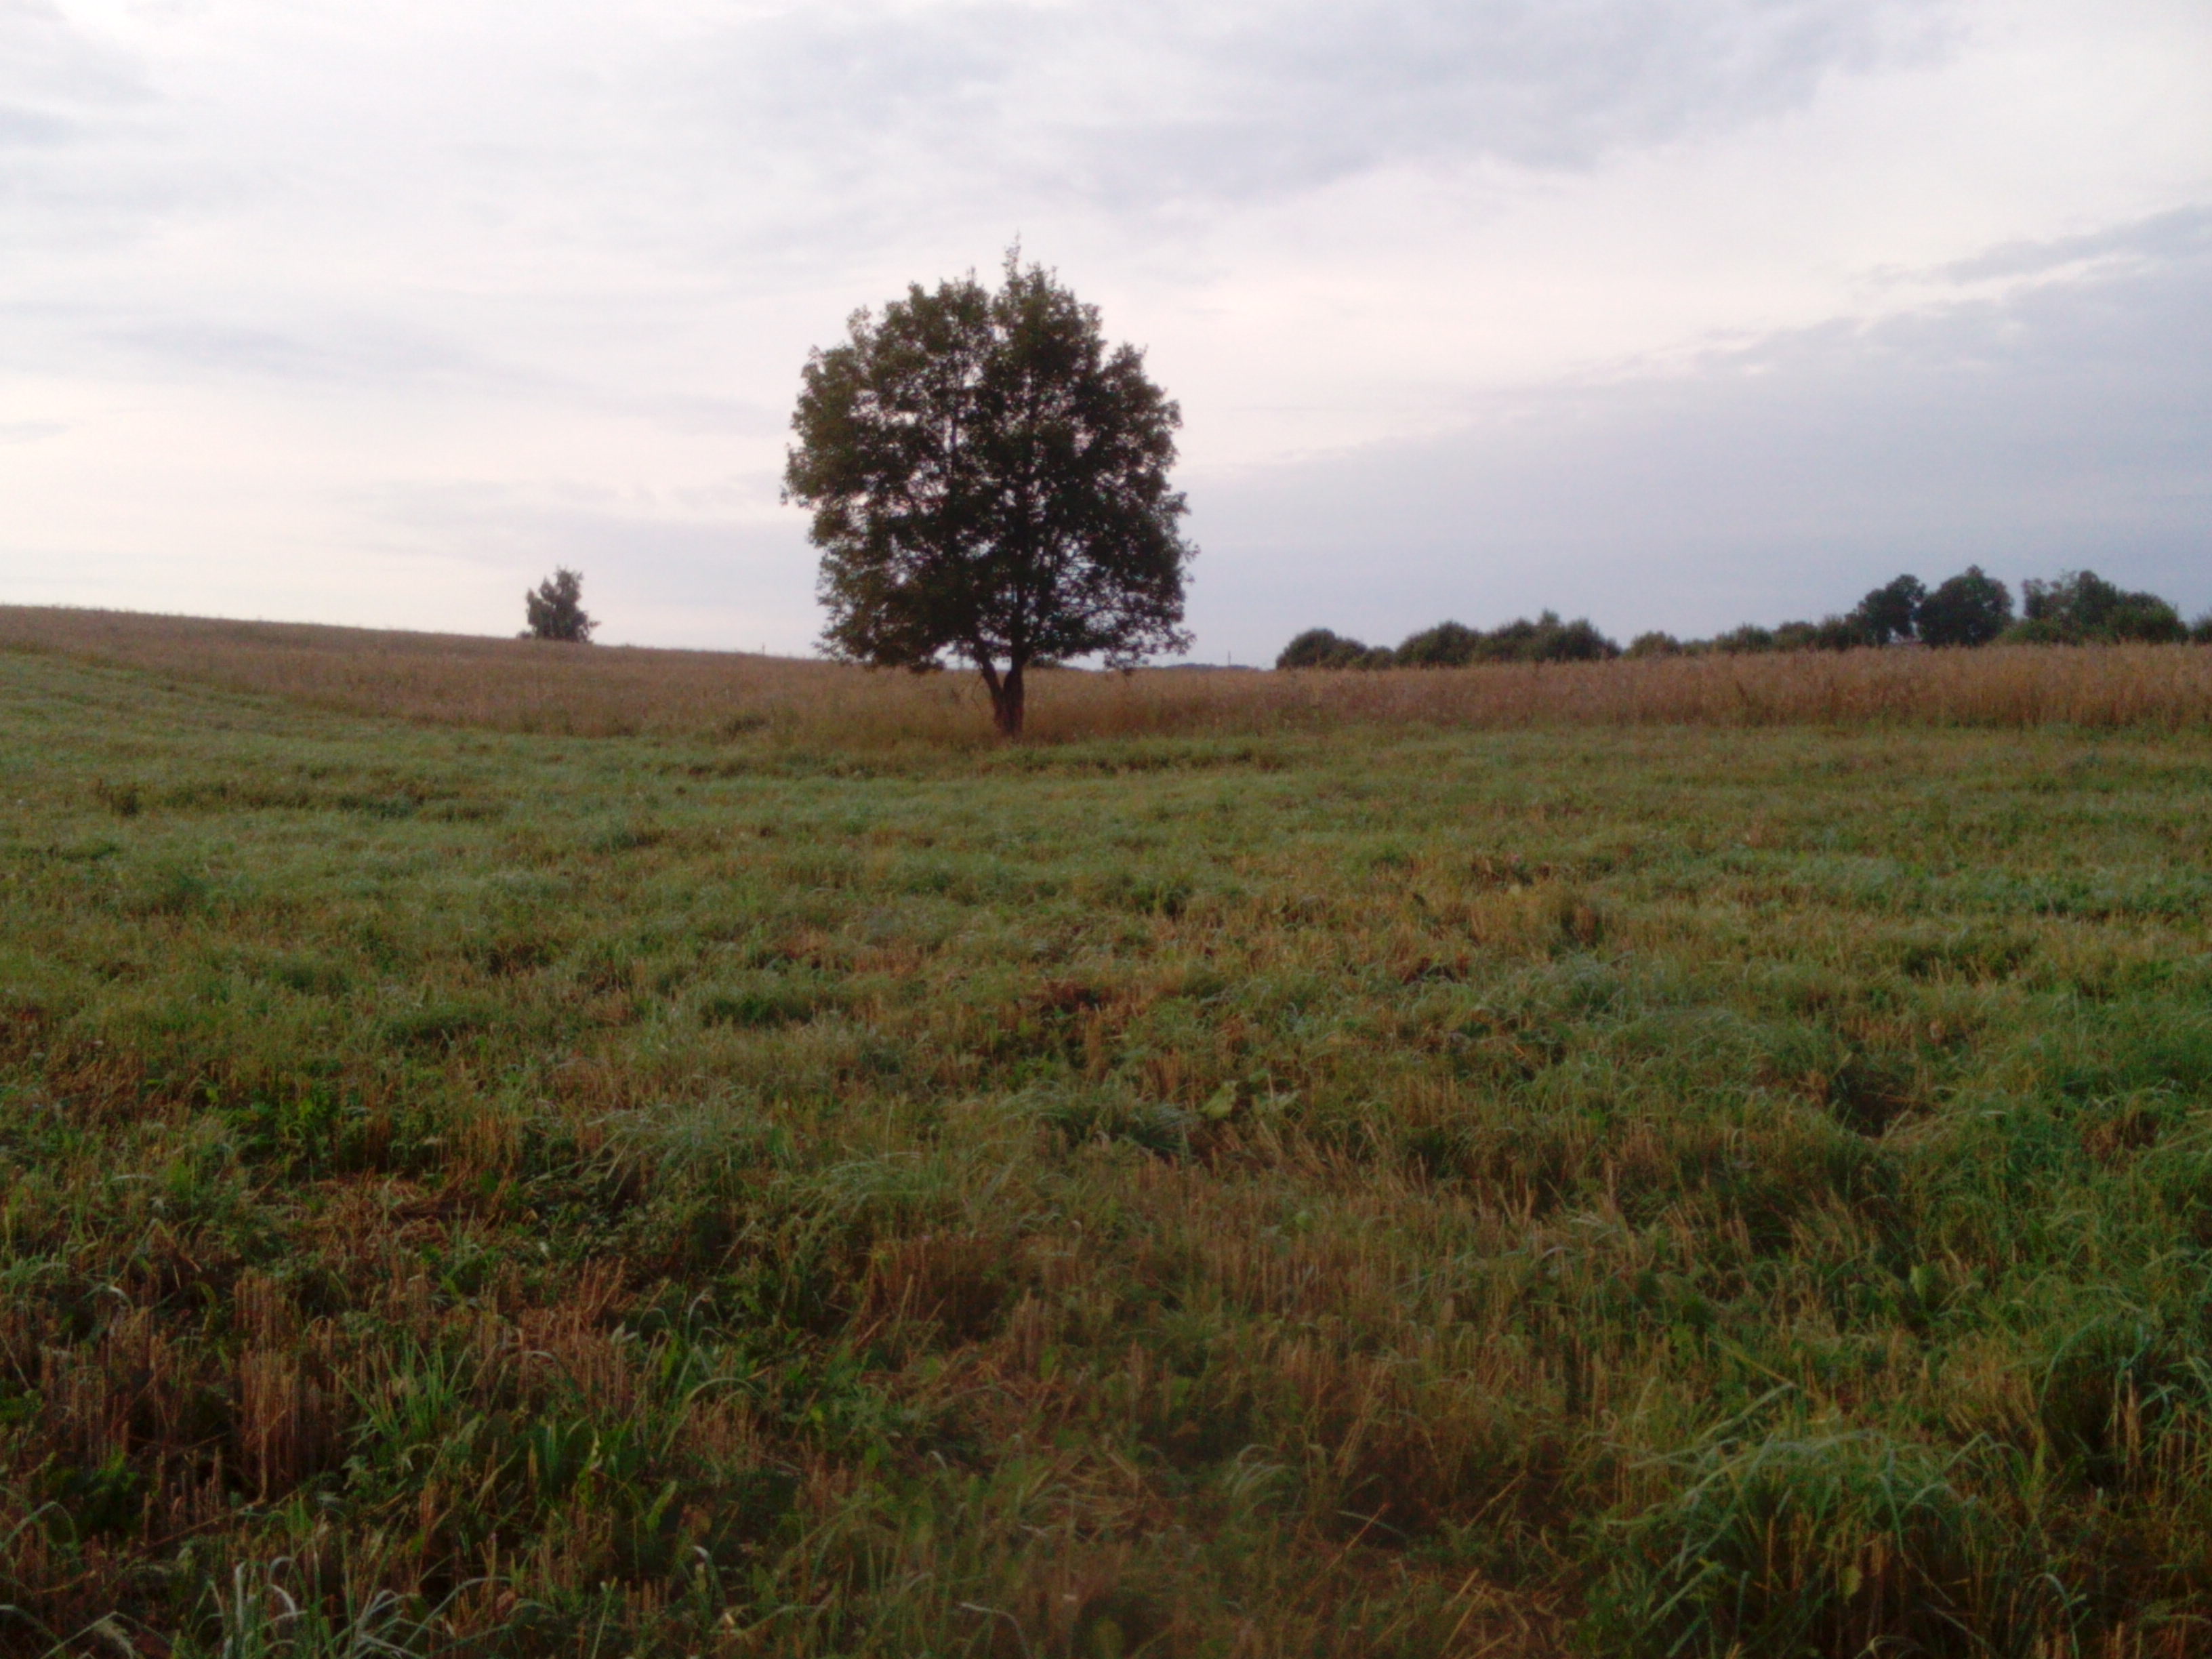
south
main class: Cropland
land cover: Common wheat
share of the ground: > 75 %
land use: Agriculture (excluding fallow land and kitchen gardens)
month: September
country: LT
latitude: 55.7085
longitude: 22.4250
